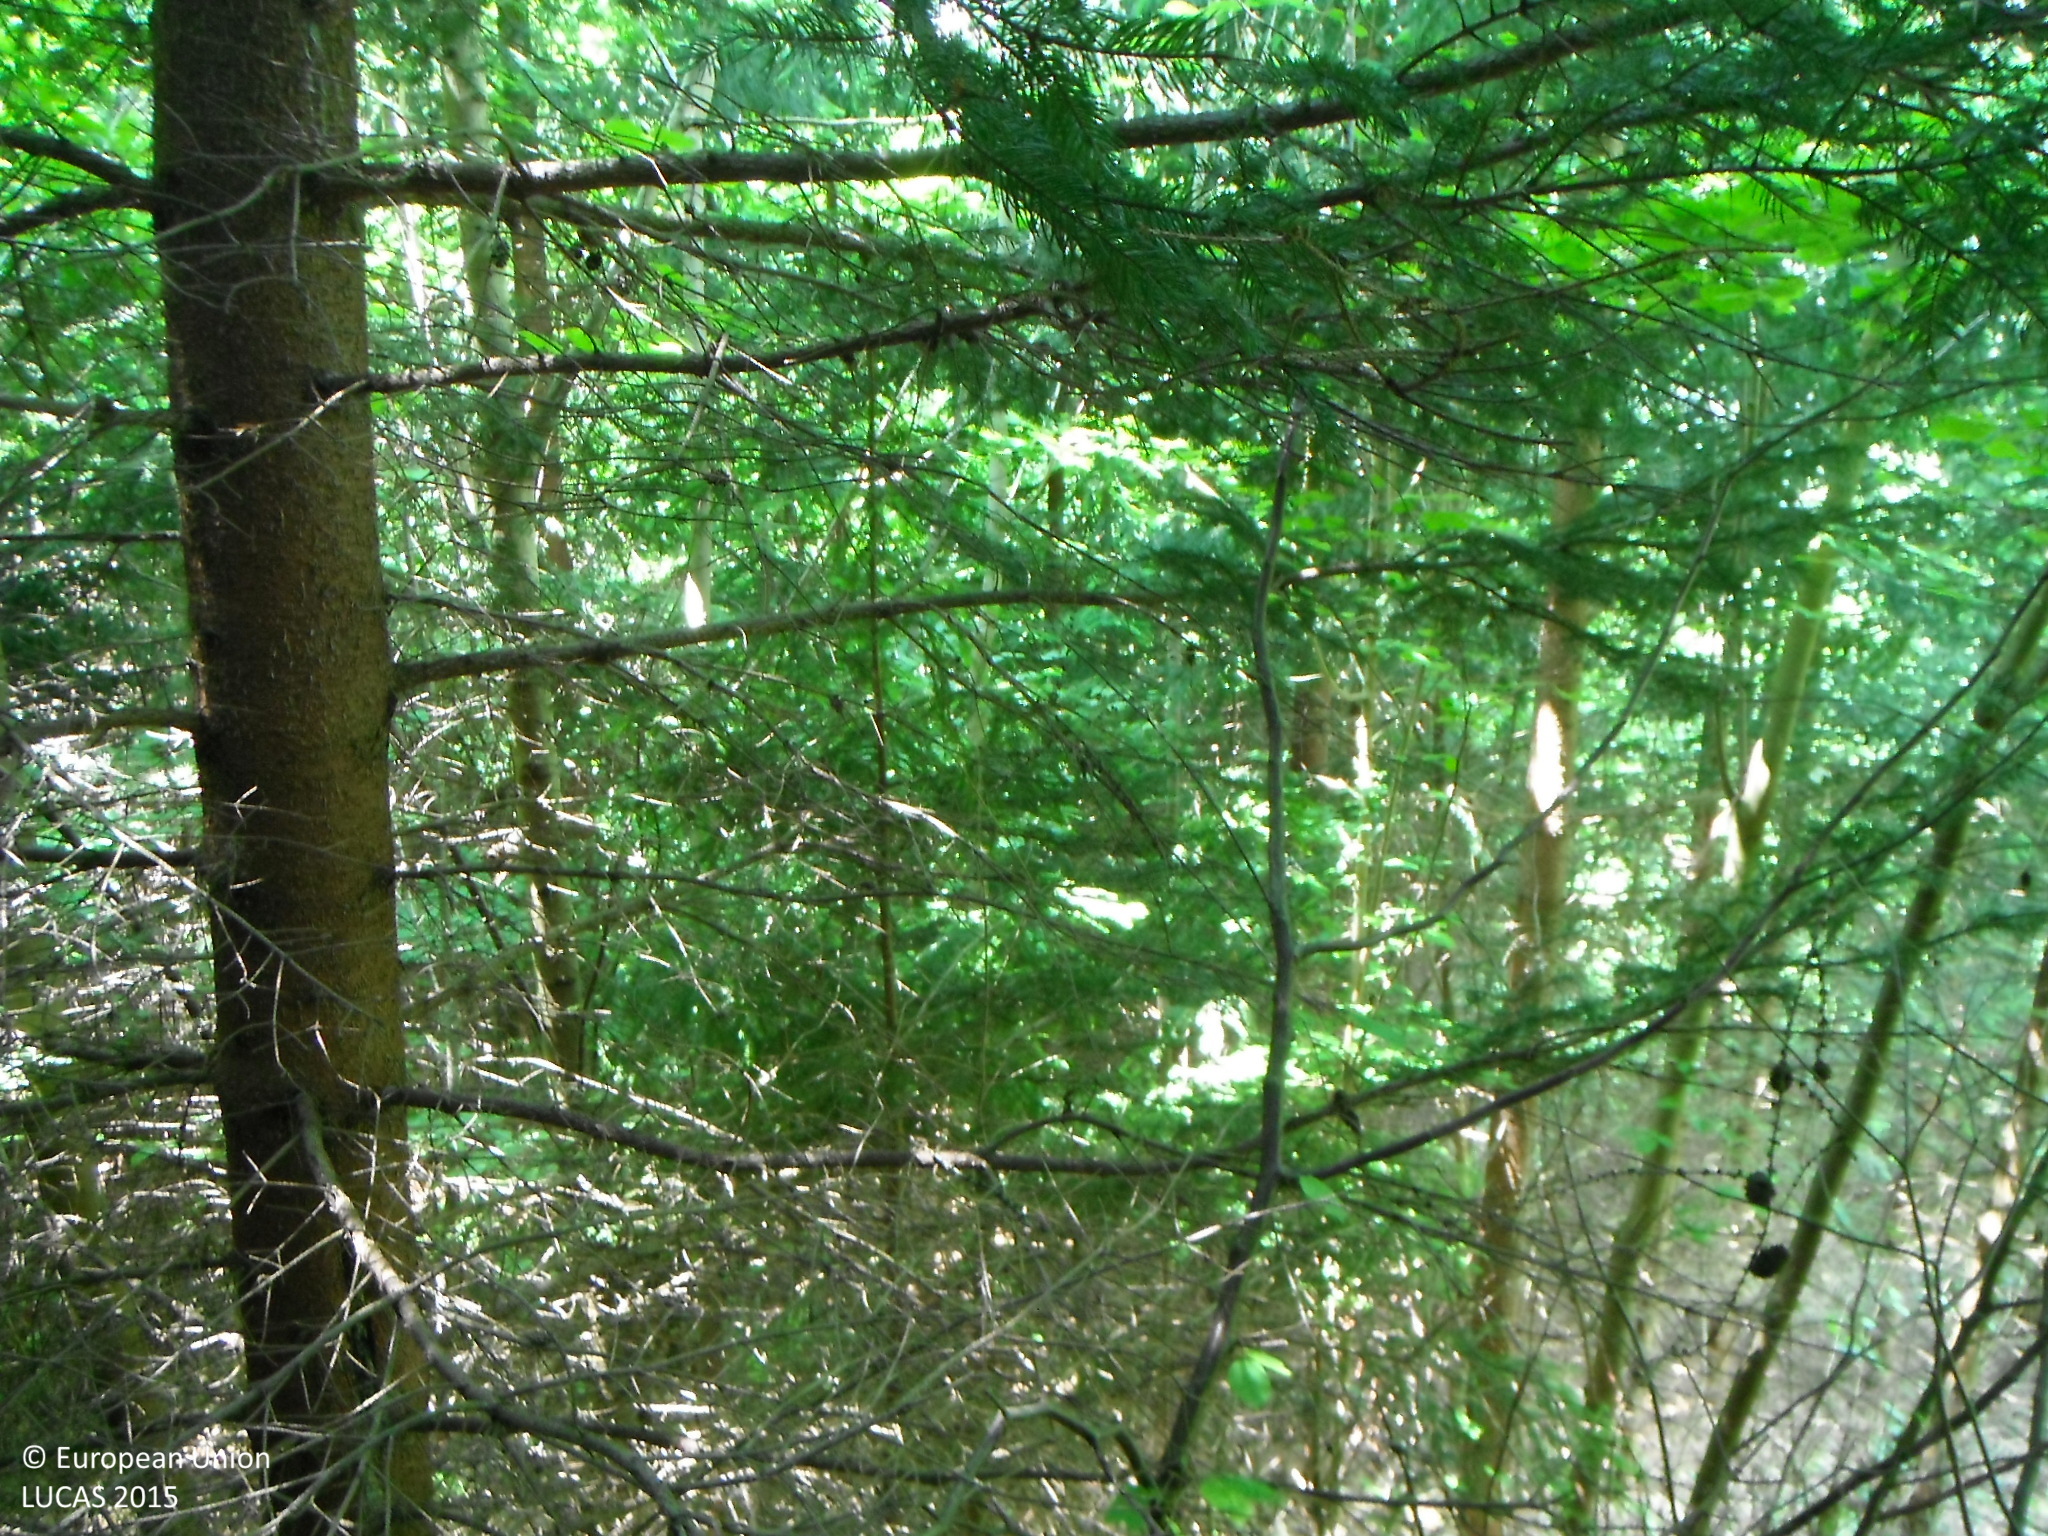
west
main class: Woodland
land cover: Spruce dominated coniferous woodland
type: alpine coniferous forest
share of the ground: > 75 %
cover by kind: coniferous forest trees 100 %
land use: Forestry
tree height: > 5 m
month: June
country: SK
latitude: 49.1222
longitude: 19.2180
